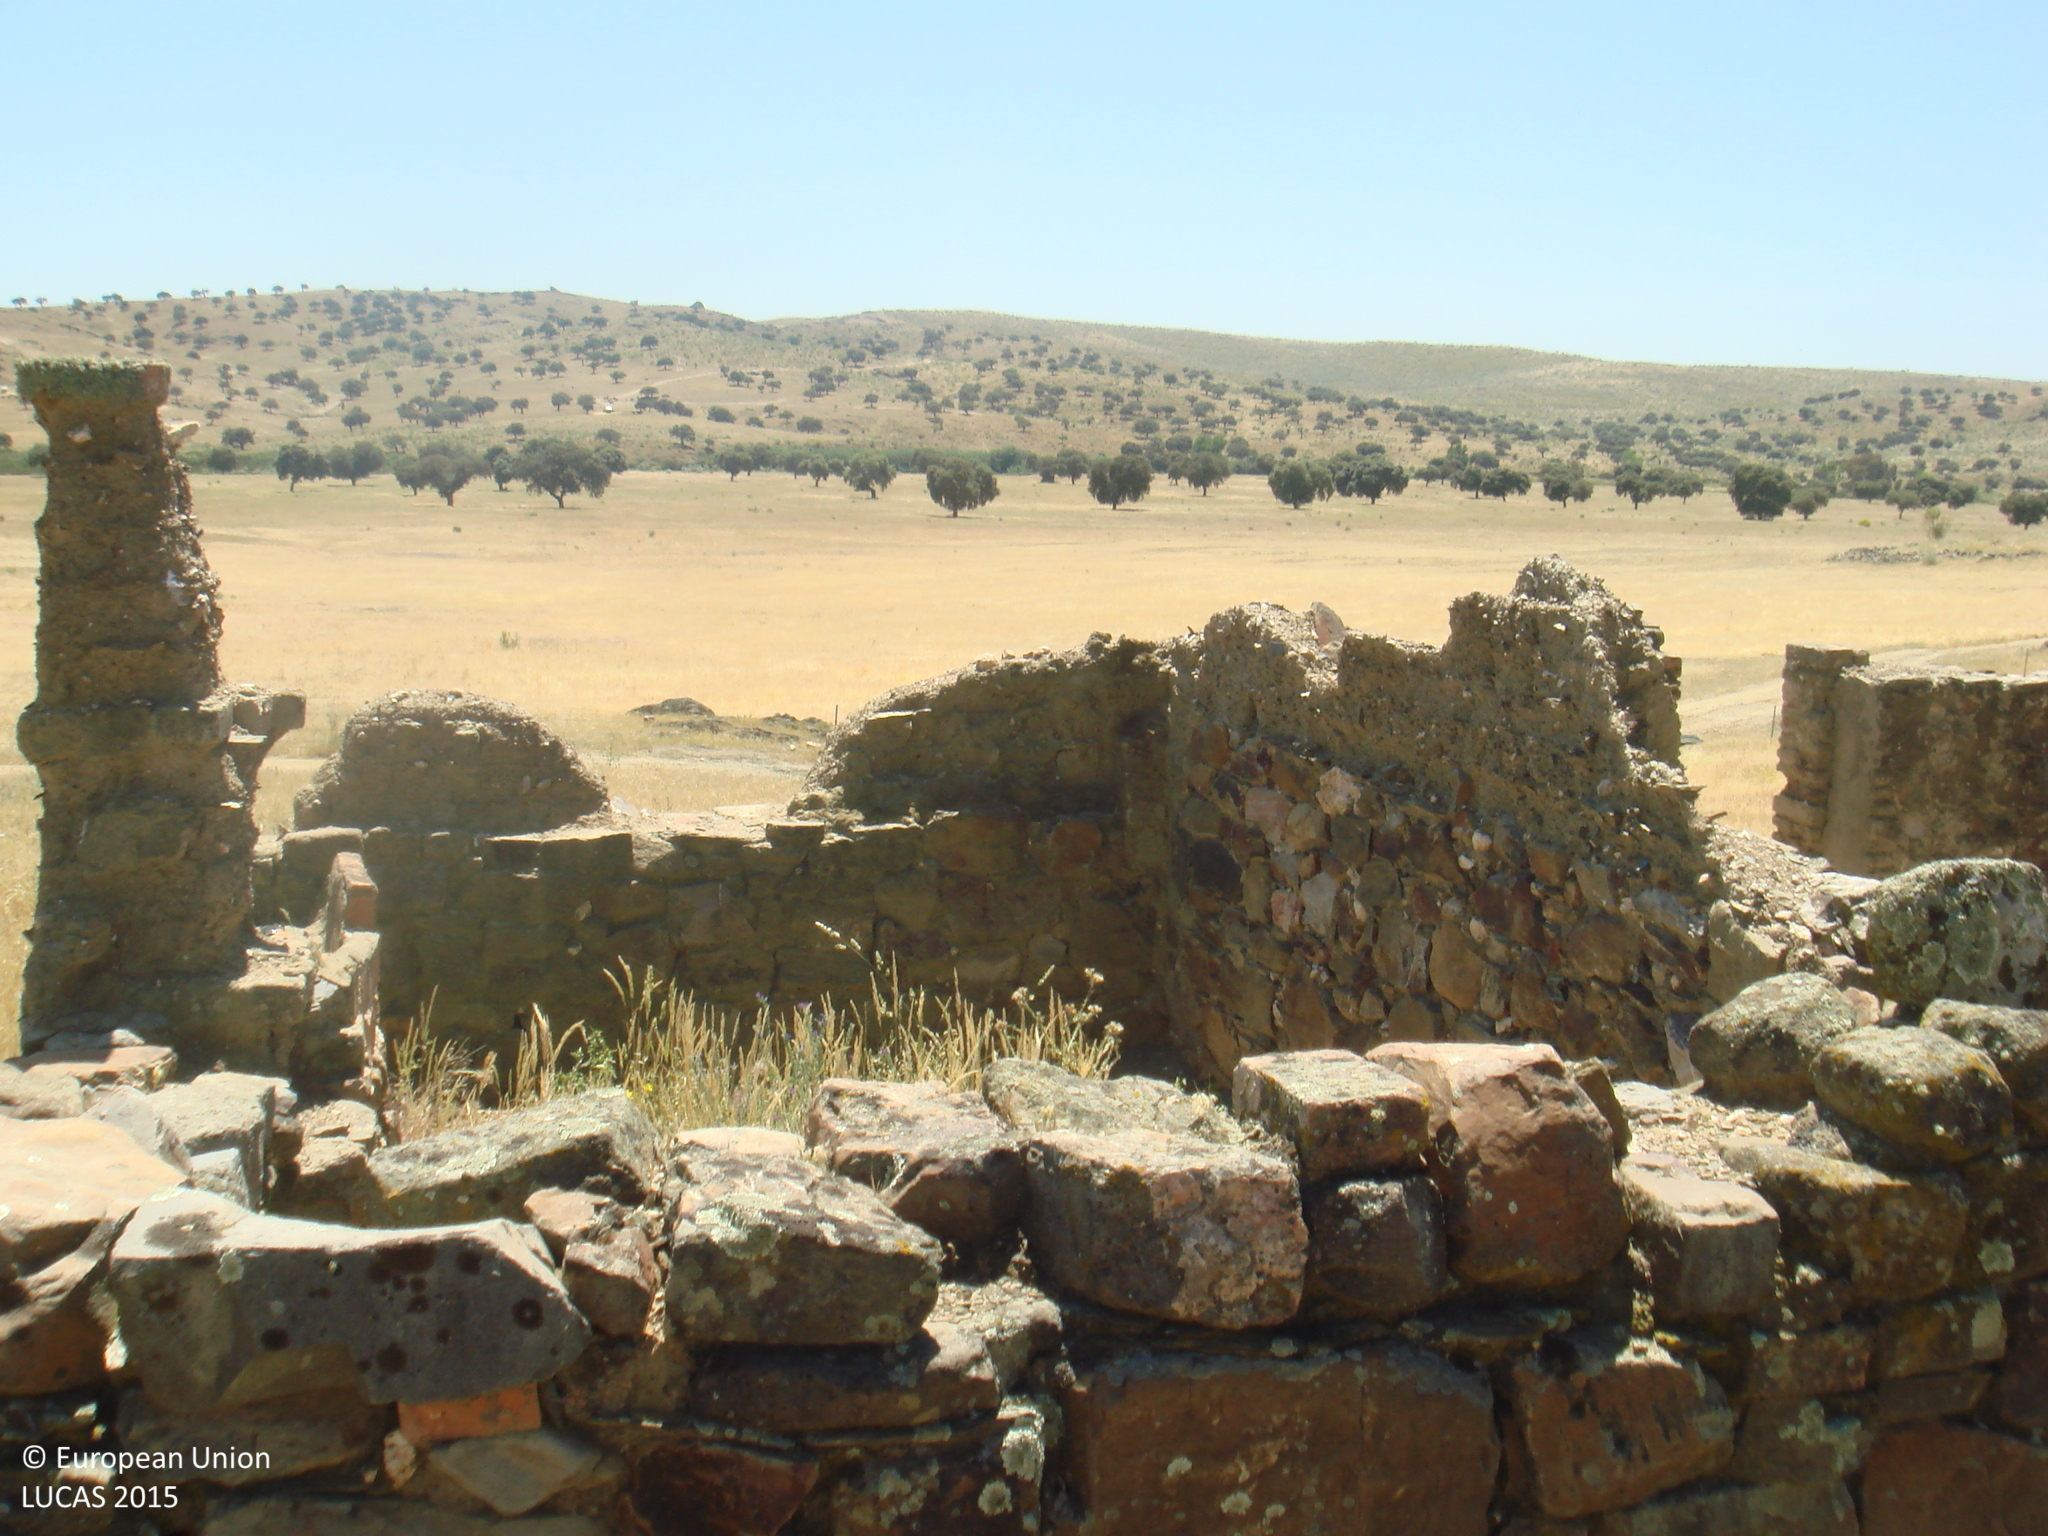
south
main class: Grassland
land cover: Grassland without tree/shrub cover
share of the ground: > 75 %
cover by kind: herbaceous plants 80 %
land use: Agriculture (excluding fallow land and kitchen gardens)
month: May
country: ES
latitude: 38.6826
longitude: -5.1261
